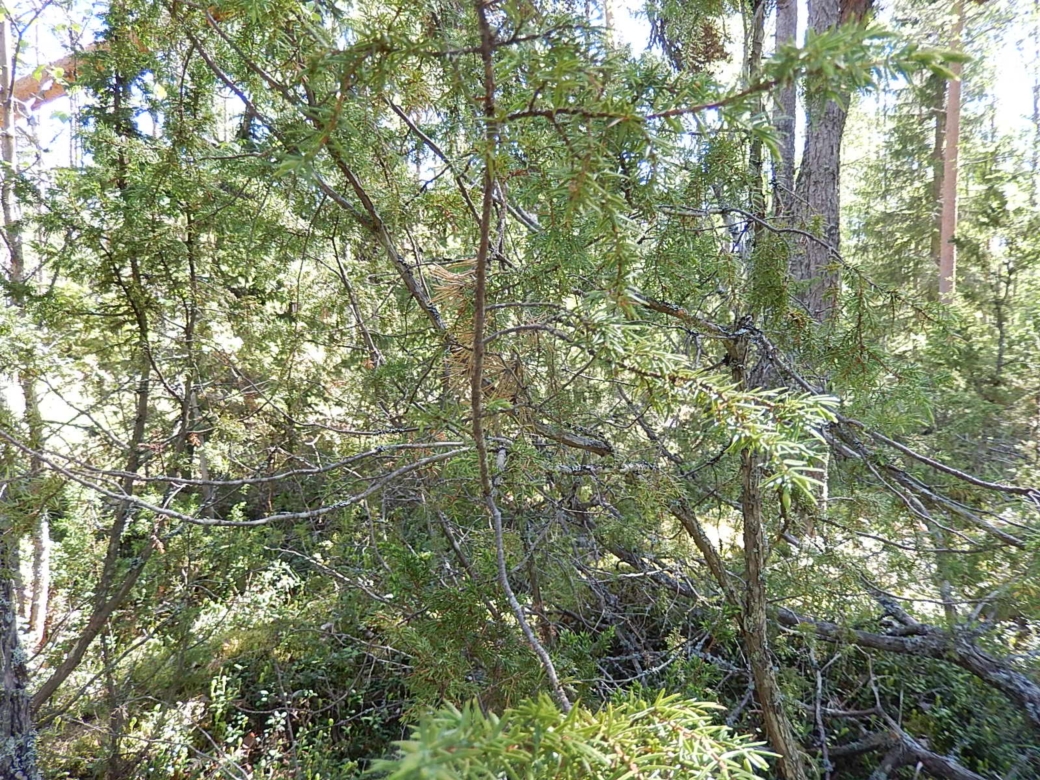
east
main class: Woodland
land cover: Pine dominated mixed woodland
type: boreal forest
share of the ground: 50 - 75 %
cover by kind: coniferous forest trees 50 %, broadleaved forest trees 20 %, shrubs 20 %, lichens and mosses 10 %
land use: Forestry
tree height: > 5 m
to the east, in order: Pine dominated mixed woodland; Pine dominated coniferous woodland; Tracks; Pine dominated coniferous woodland; Ditches and canals; Pine dominated coniferous woodland
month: June
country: FI
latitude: 62.0751
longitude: 21.5507
